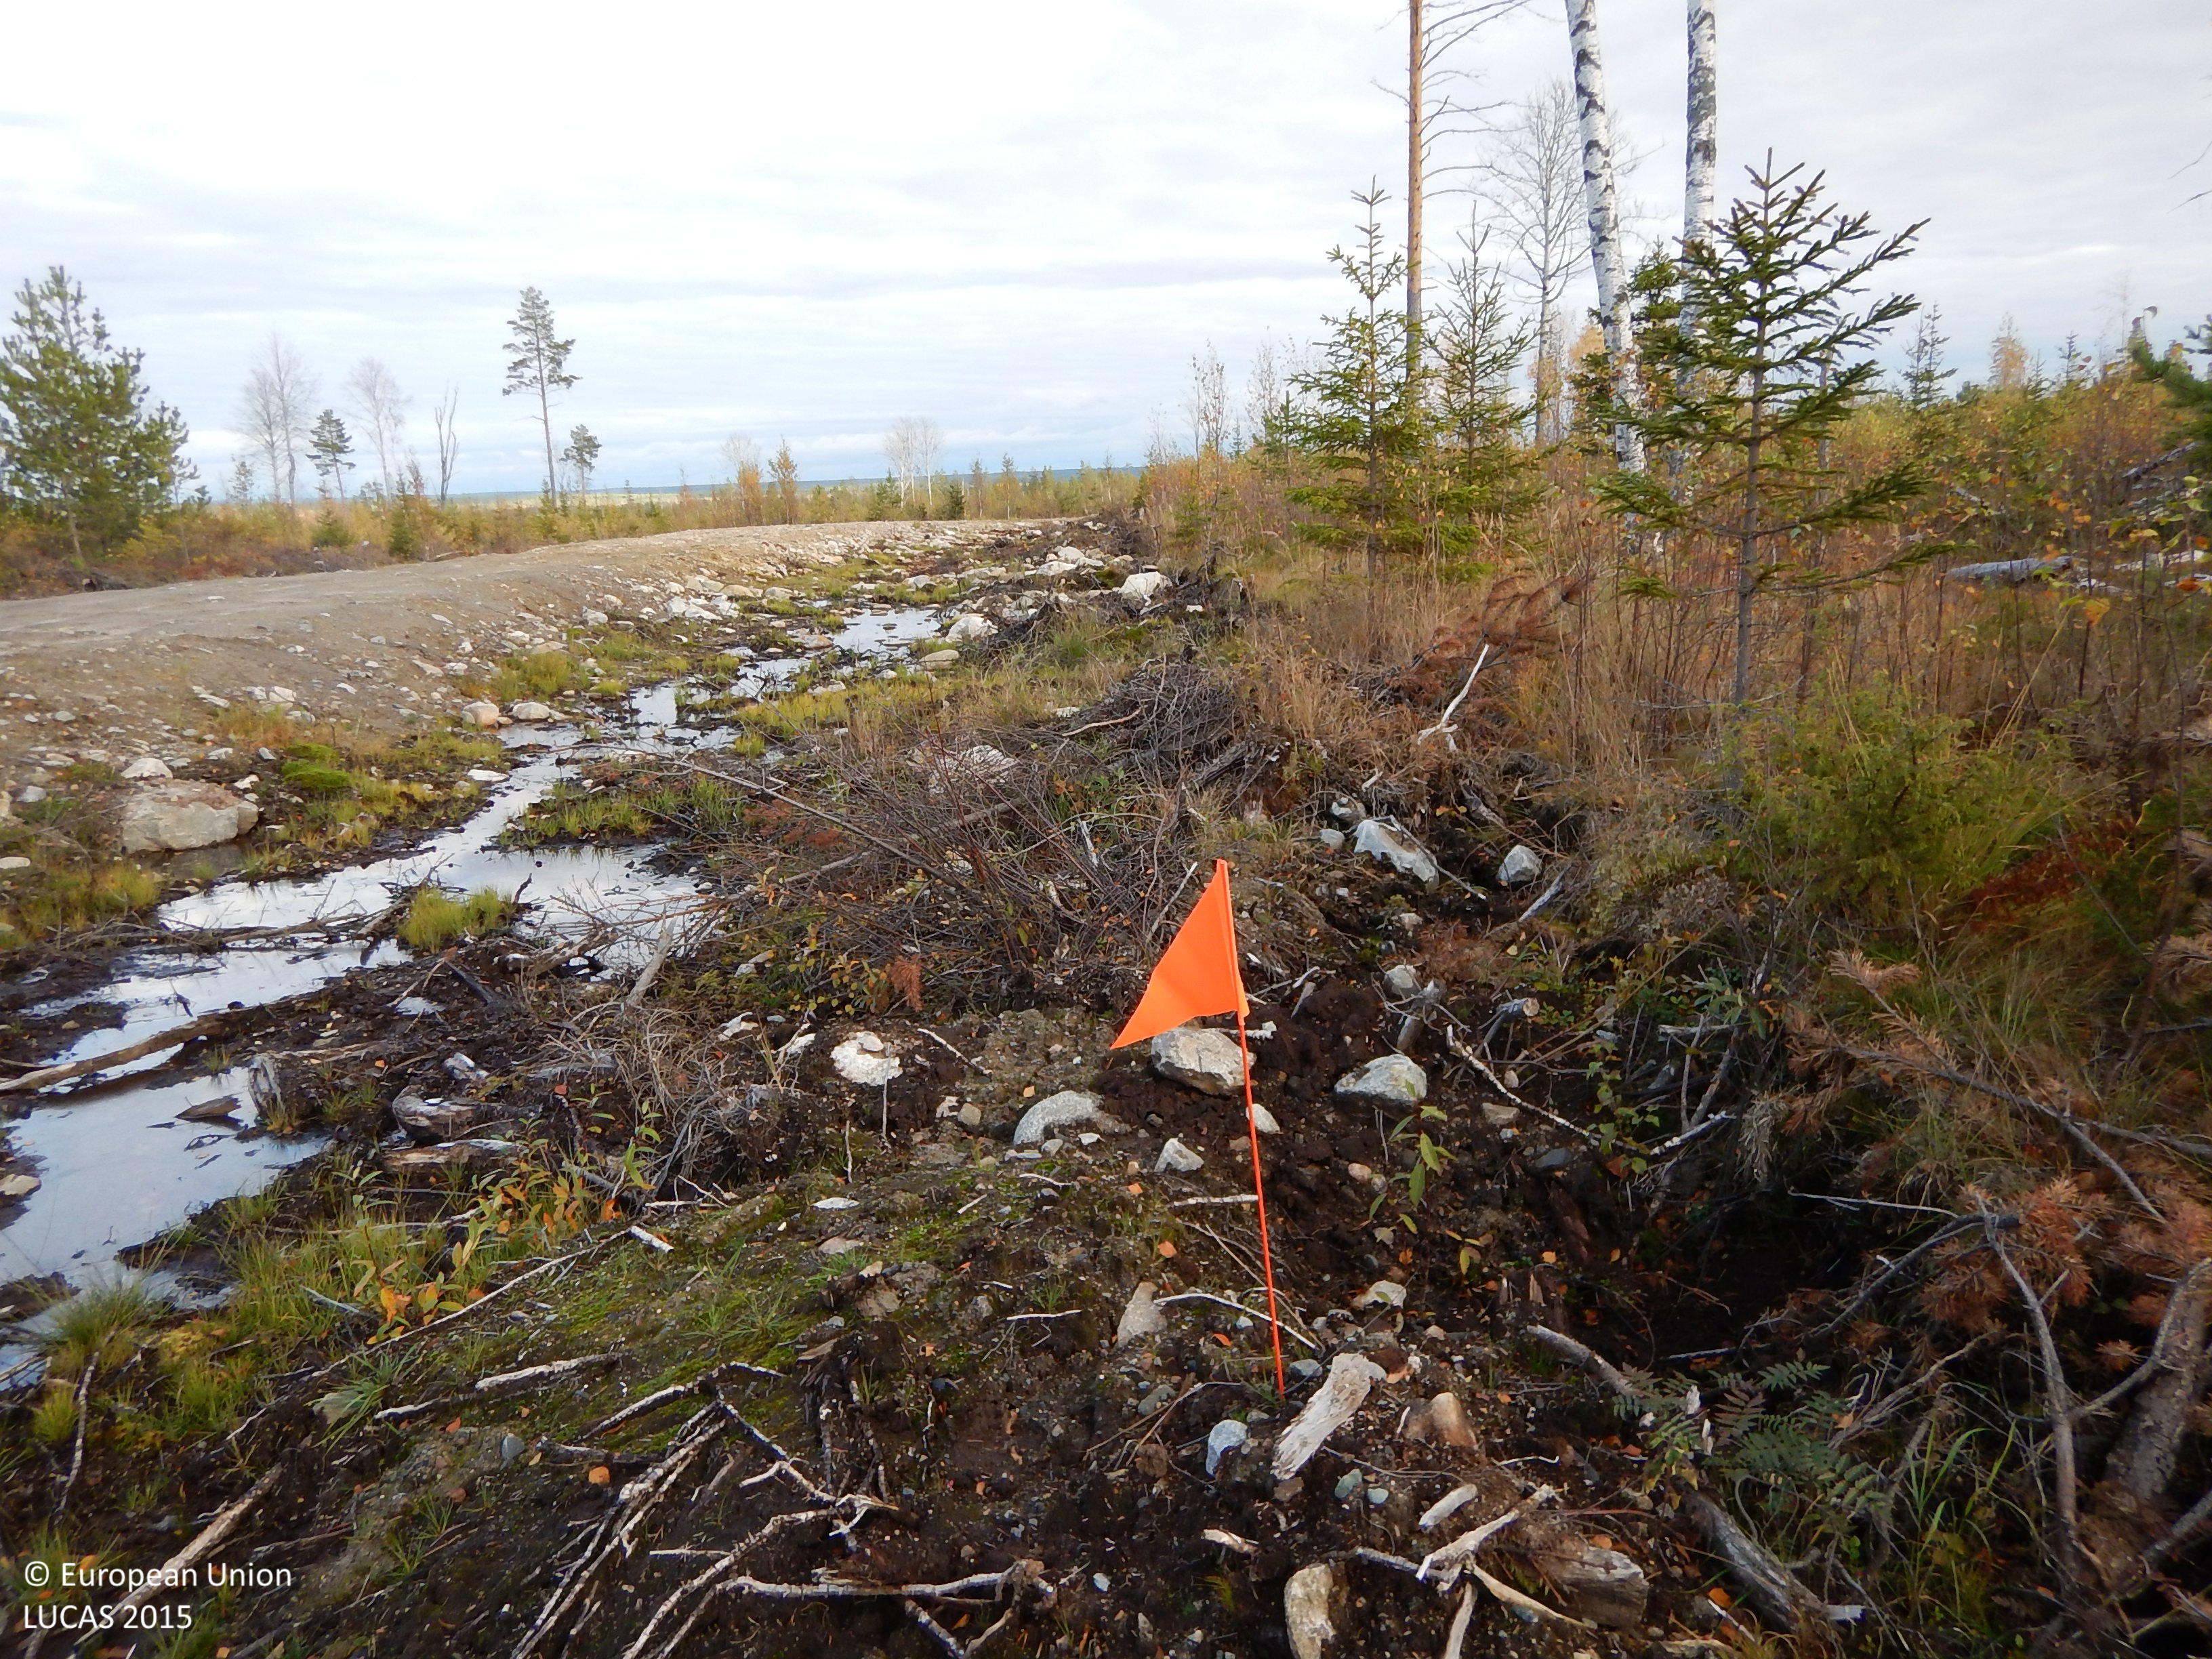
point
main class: Woodland
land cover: Other mixed woodland
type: boreal forest
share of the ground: 50 - 75 %
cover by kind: coniferous forest trees 45 %, broadleaved forest trees 25 %, herbaceous plants 15 %, shrubs 10 %, lichens and mosses 5 %
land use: Forestry
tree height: < 5 m
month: October
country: SE
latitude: 64.9822
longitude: 21.0174
